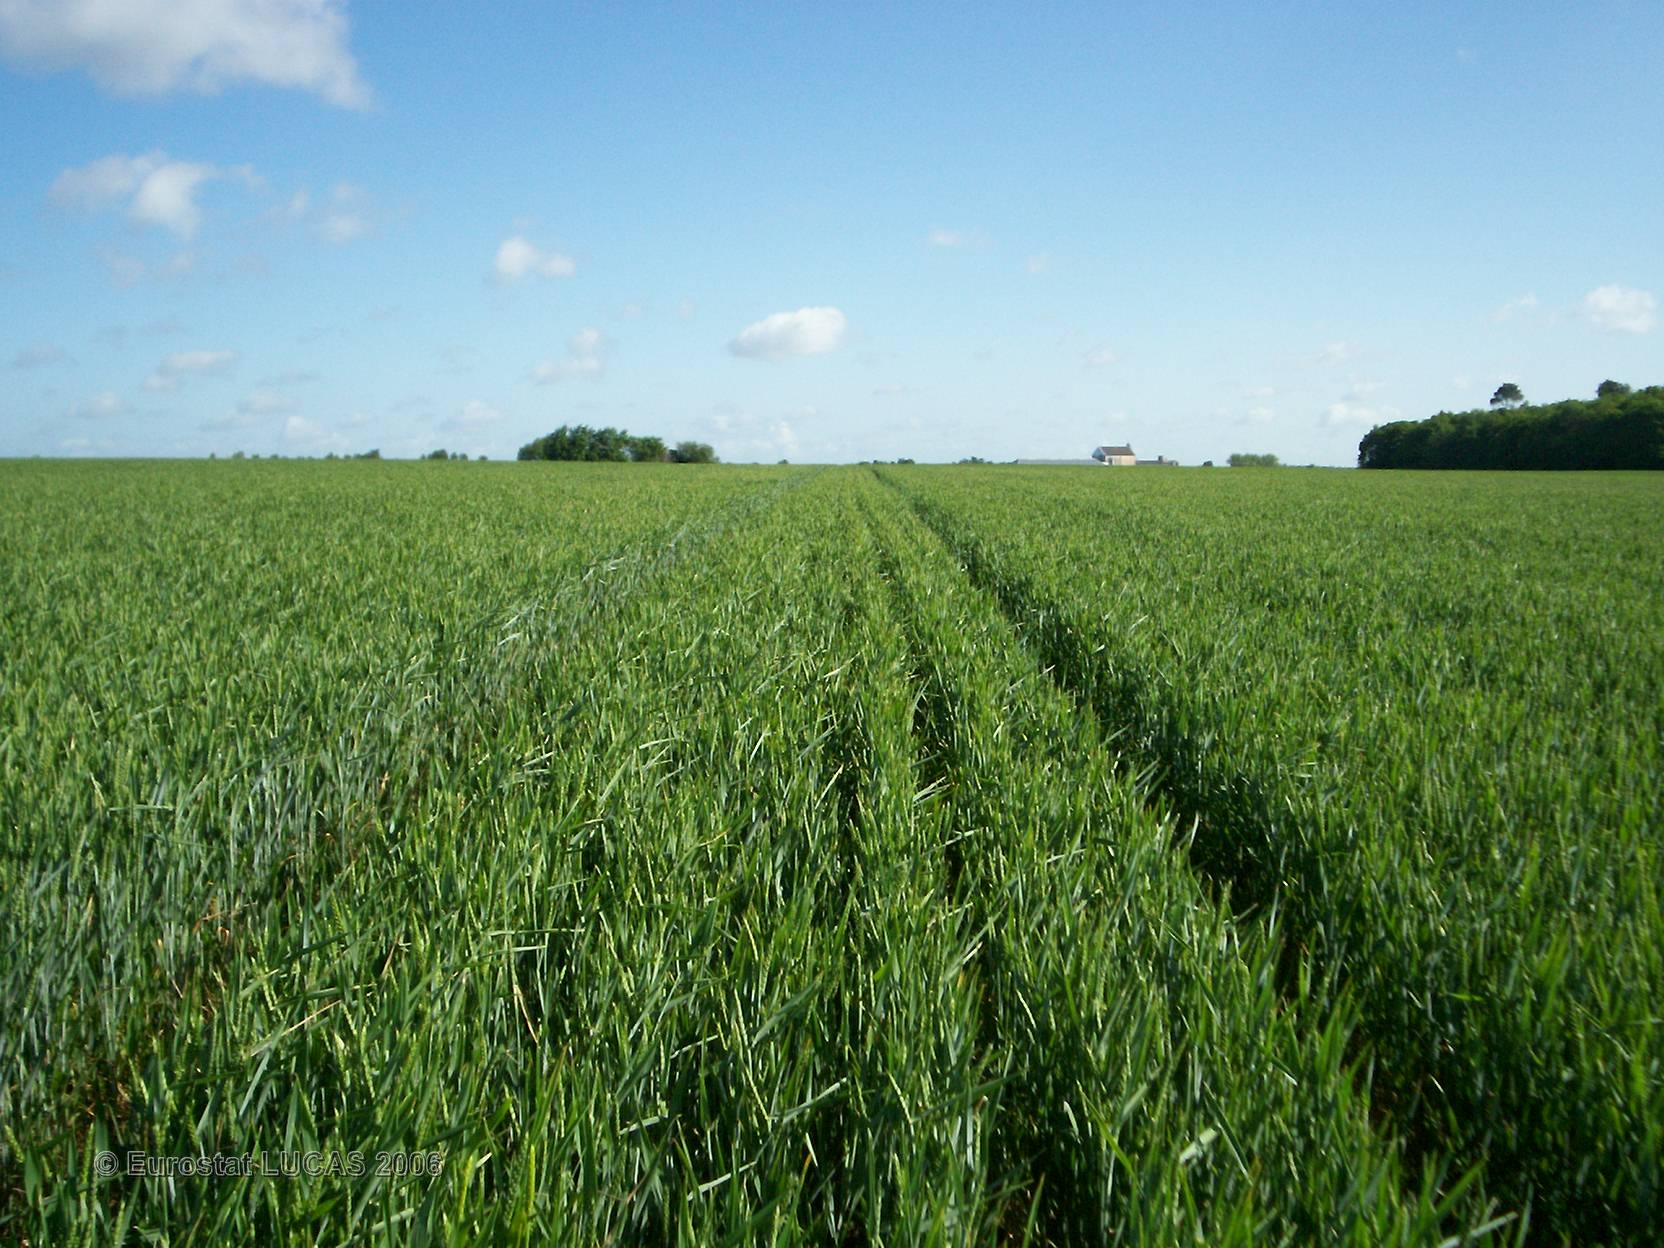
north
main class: Cropland
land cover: Common wheat
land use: Agriculture (excluding fallow land and kitchen gardens)
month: May
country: FR
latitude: 47.5171
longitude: 0.8584
